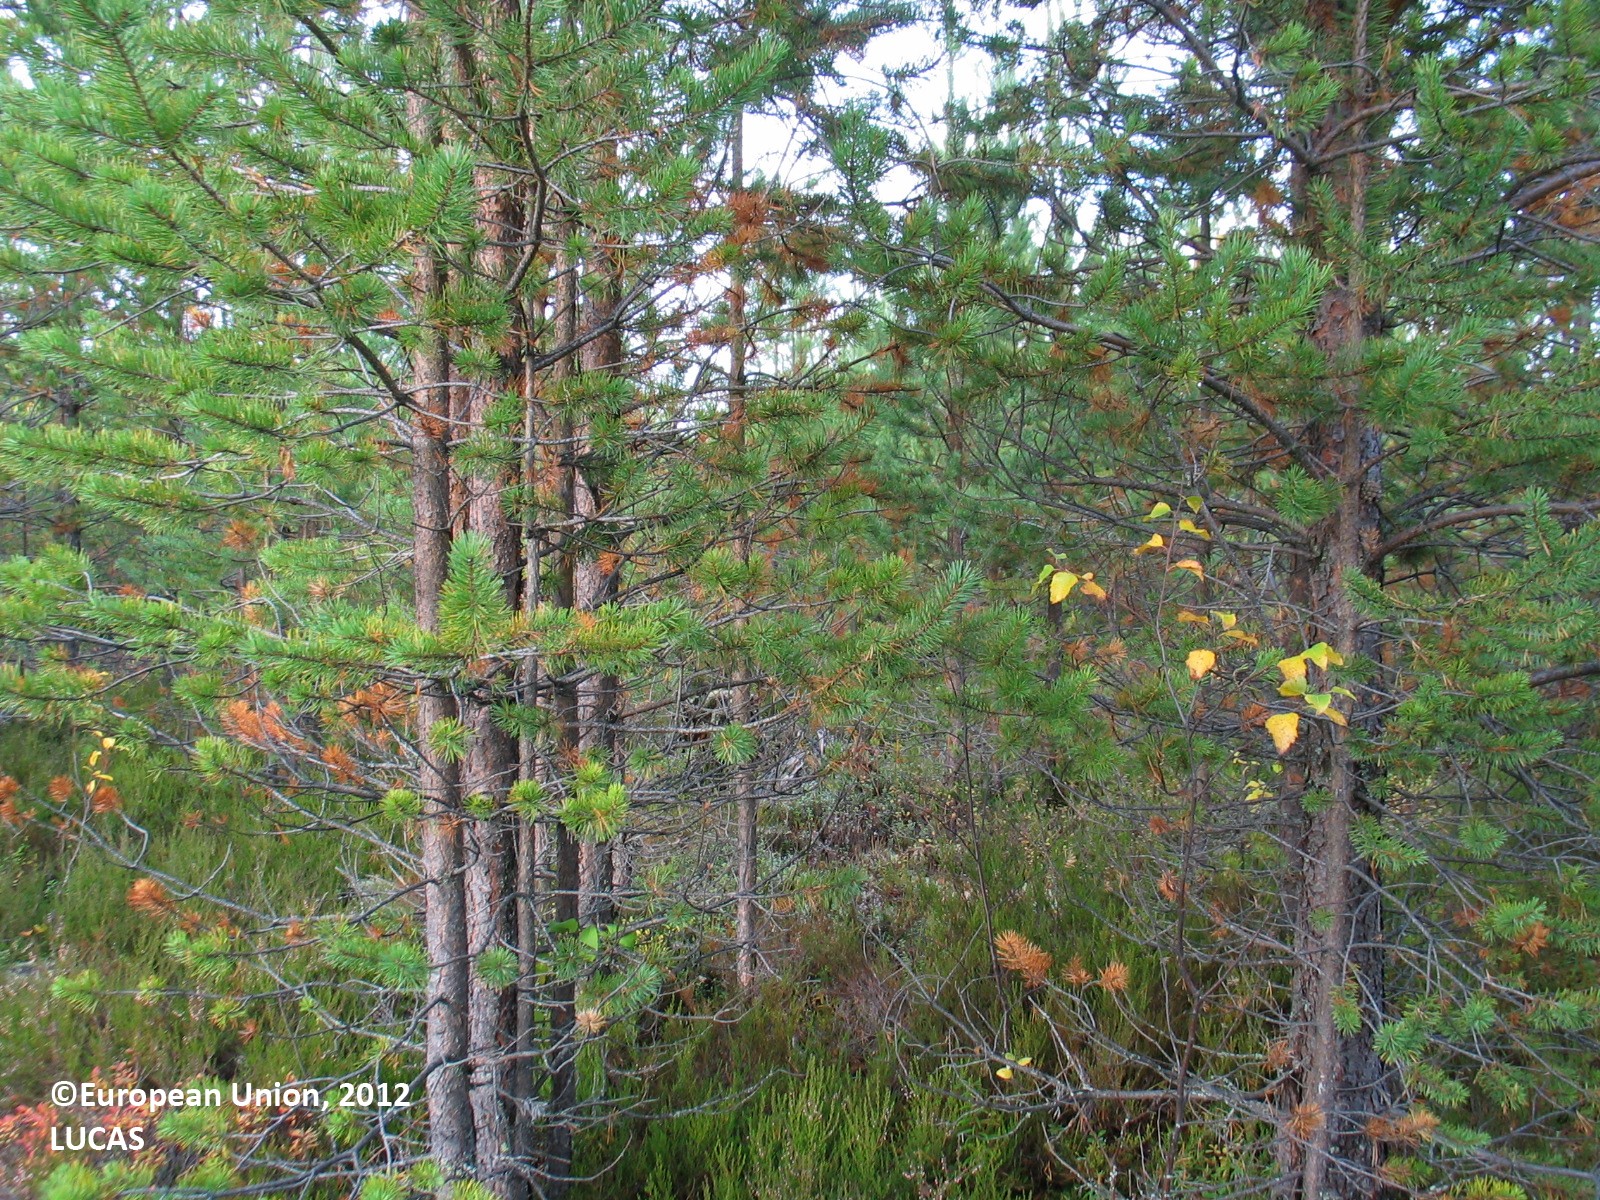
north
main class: Woodland
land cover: Pine dominated coniferous woodland
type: boreal forest
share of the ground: 25 - 50 %
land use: Forestry
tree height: < 5 m
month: September
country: FI
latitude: 65.3744
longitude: 25.6323
